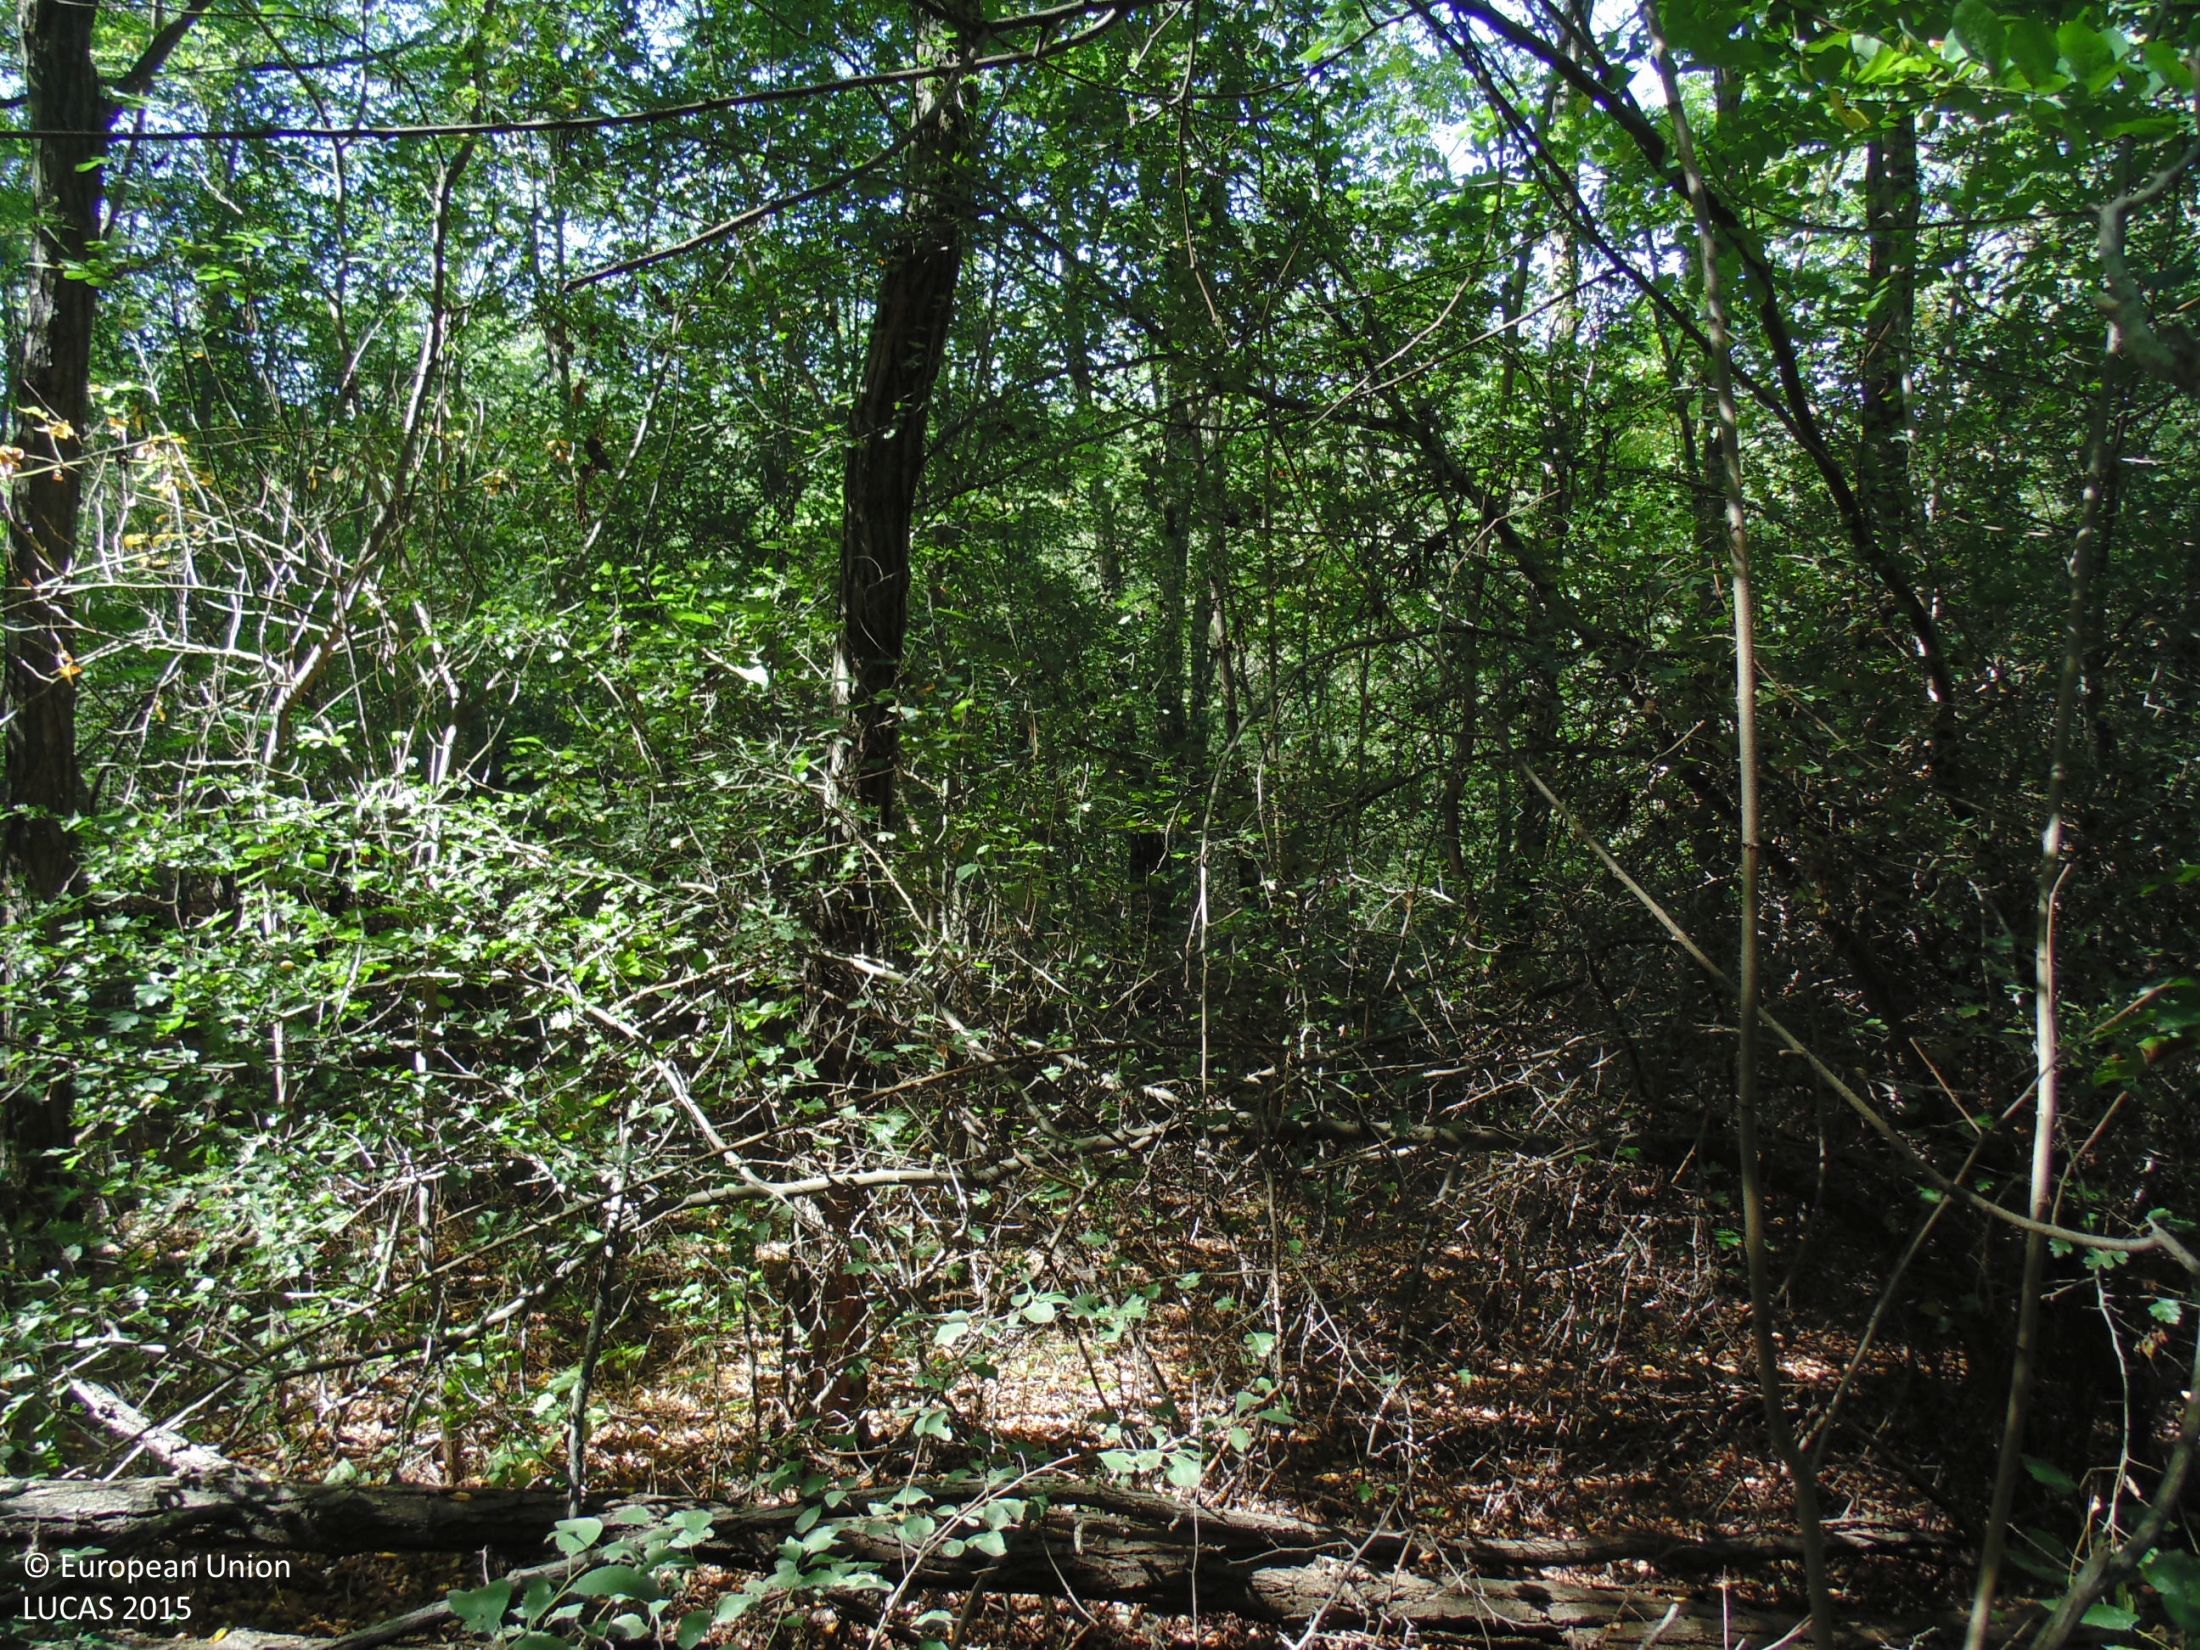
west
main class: Woodland
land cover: Broadleaved woodland
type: mesophytic deciduous forest
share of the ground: > 75 %
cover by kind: broadleaved forest trees 90 %, shrubs 5 %, herbaceous plants 5 %
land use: Forestry
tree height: > 5 m
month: September
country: BG
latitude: 44.0771
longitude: 26.9940
